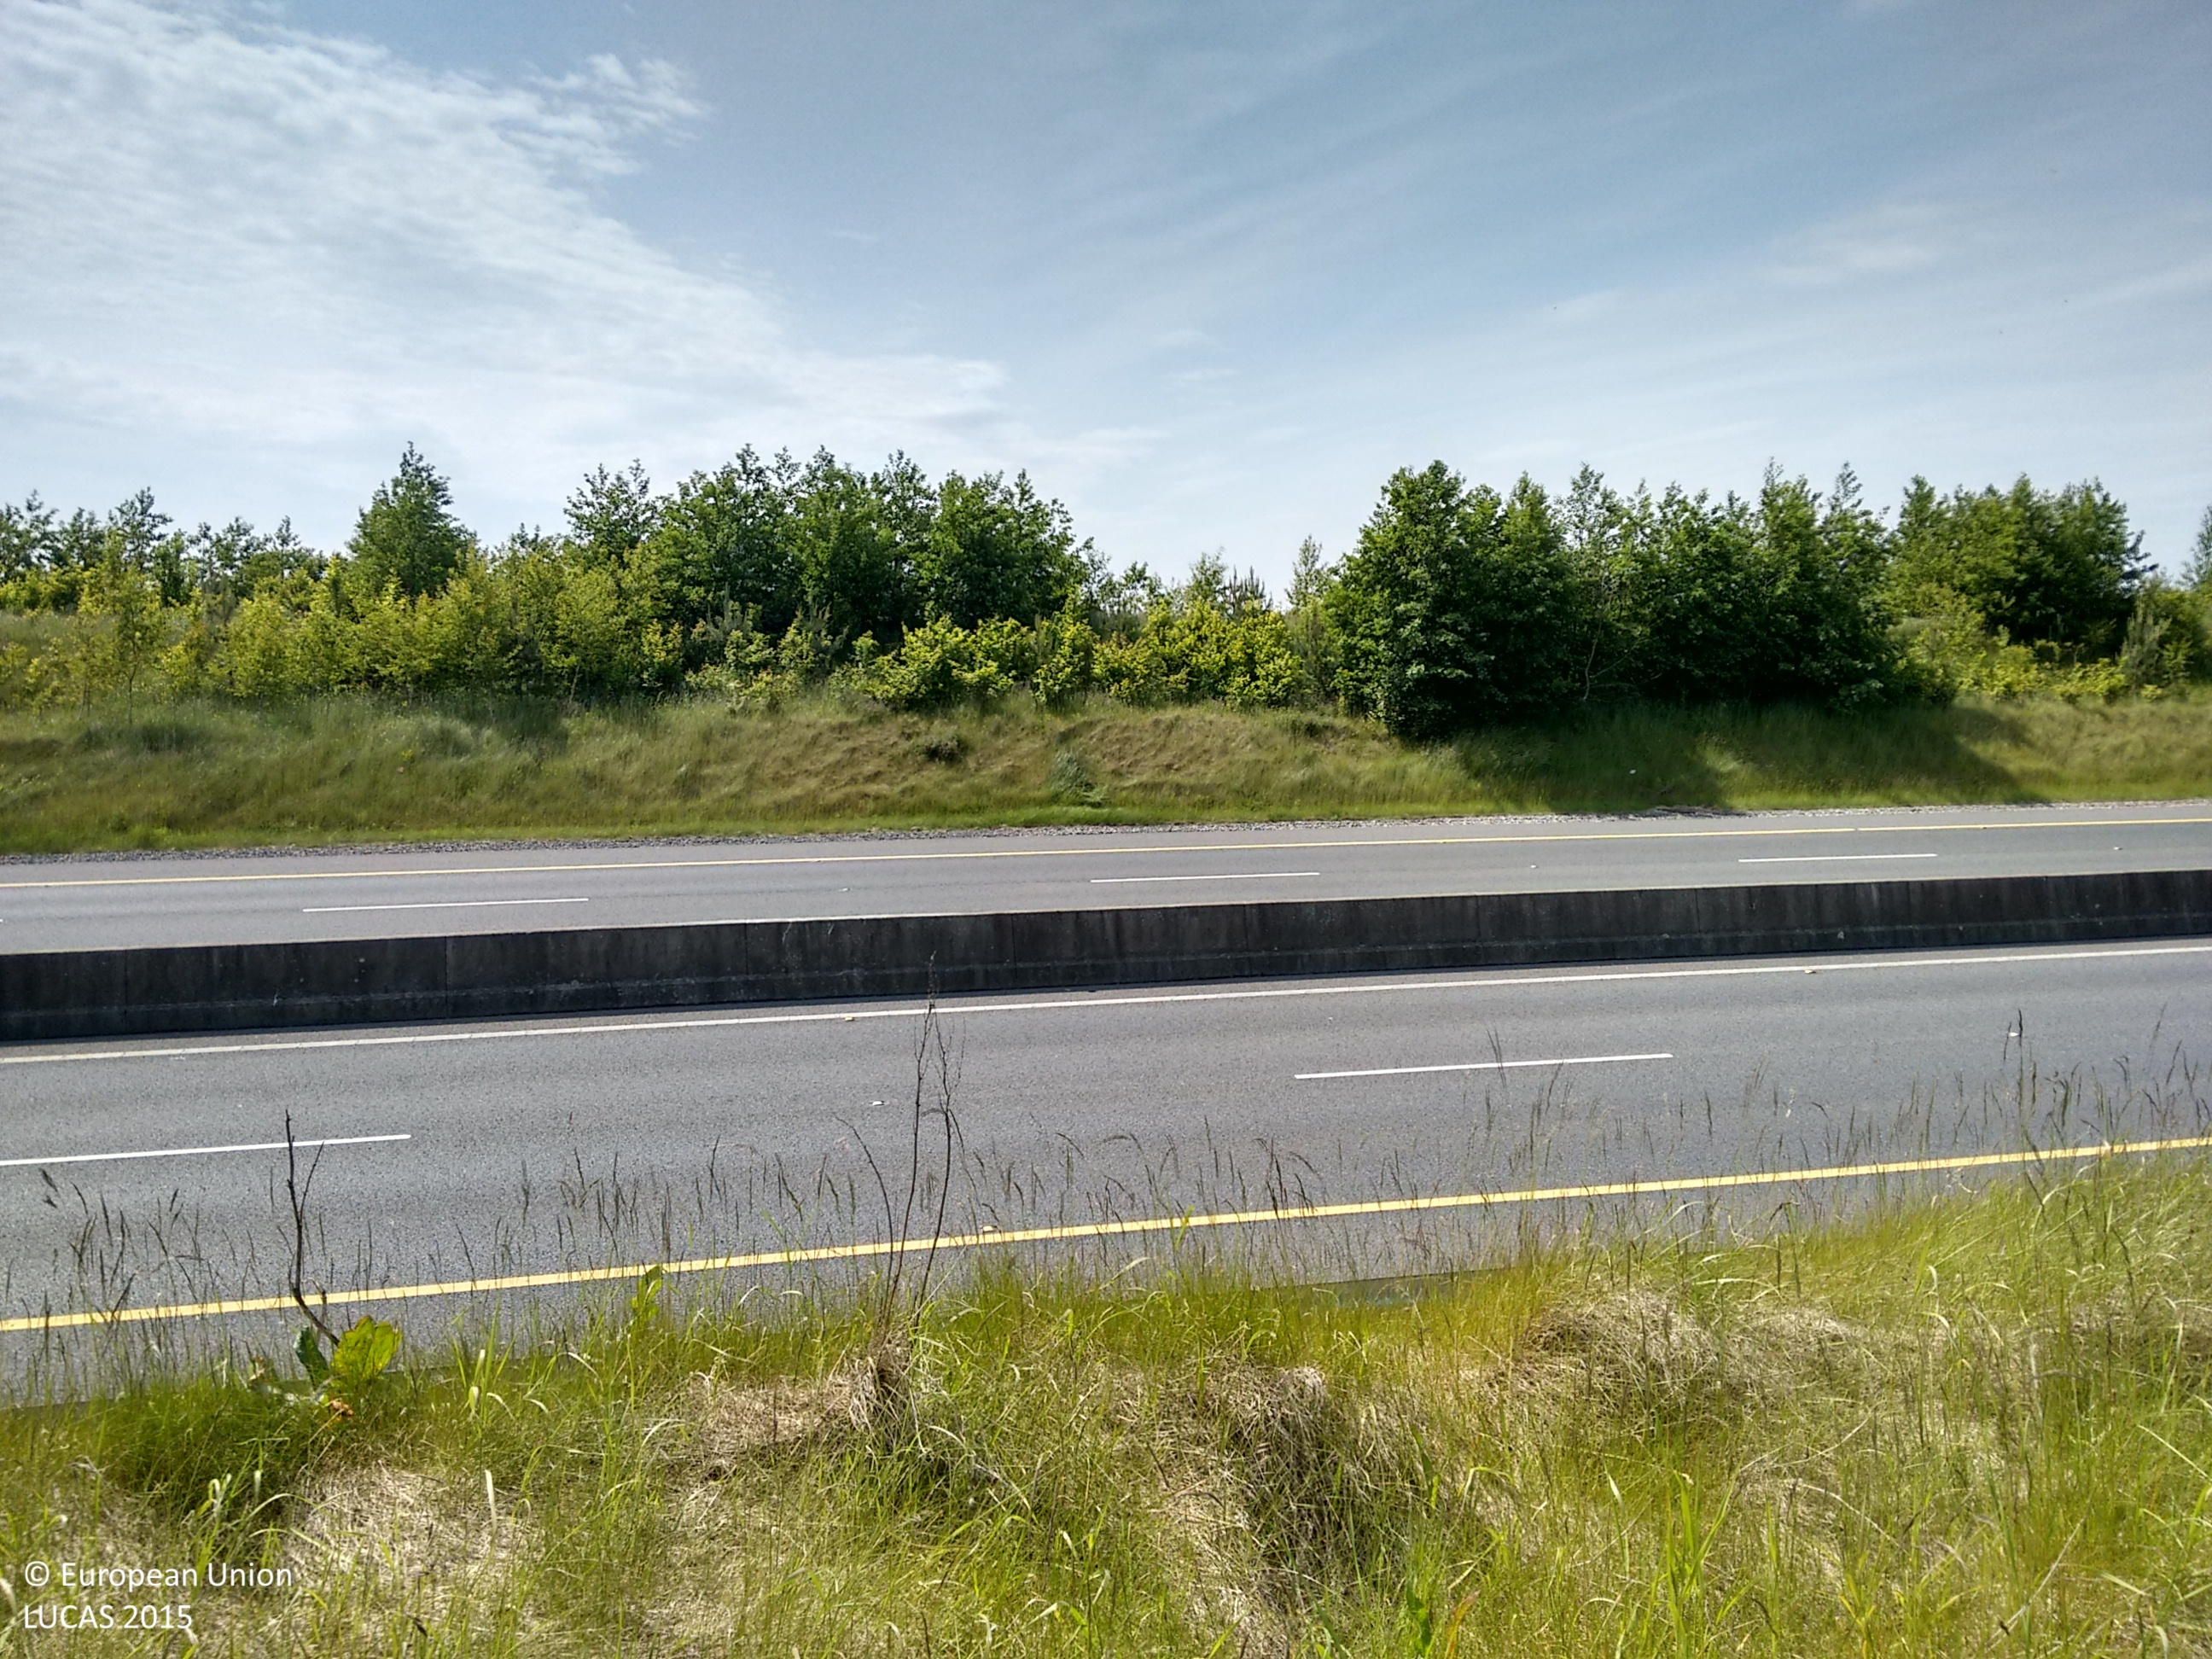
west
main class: Woodland
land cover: Broadleaved woodland
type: acidophilous oak and oak-birch forest
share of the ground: > 75 %
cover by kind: broadleaved forest trees 90 %, coniferous forest trees 10 %
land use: Road transport
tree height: < 5 m
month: June
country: IE
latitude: 53.5716
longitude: -6.5736
